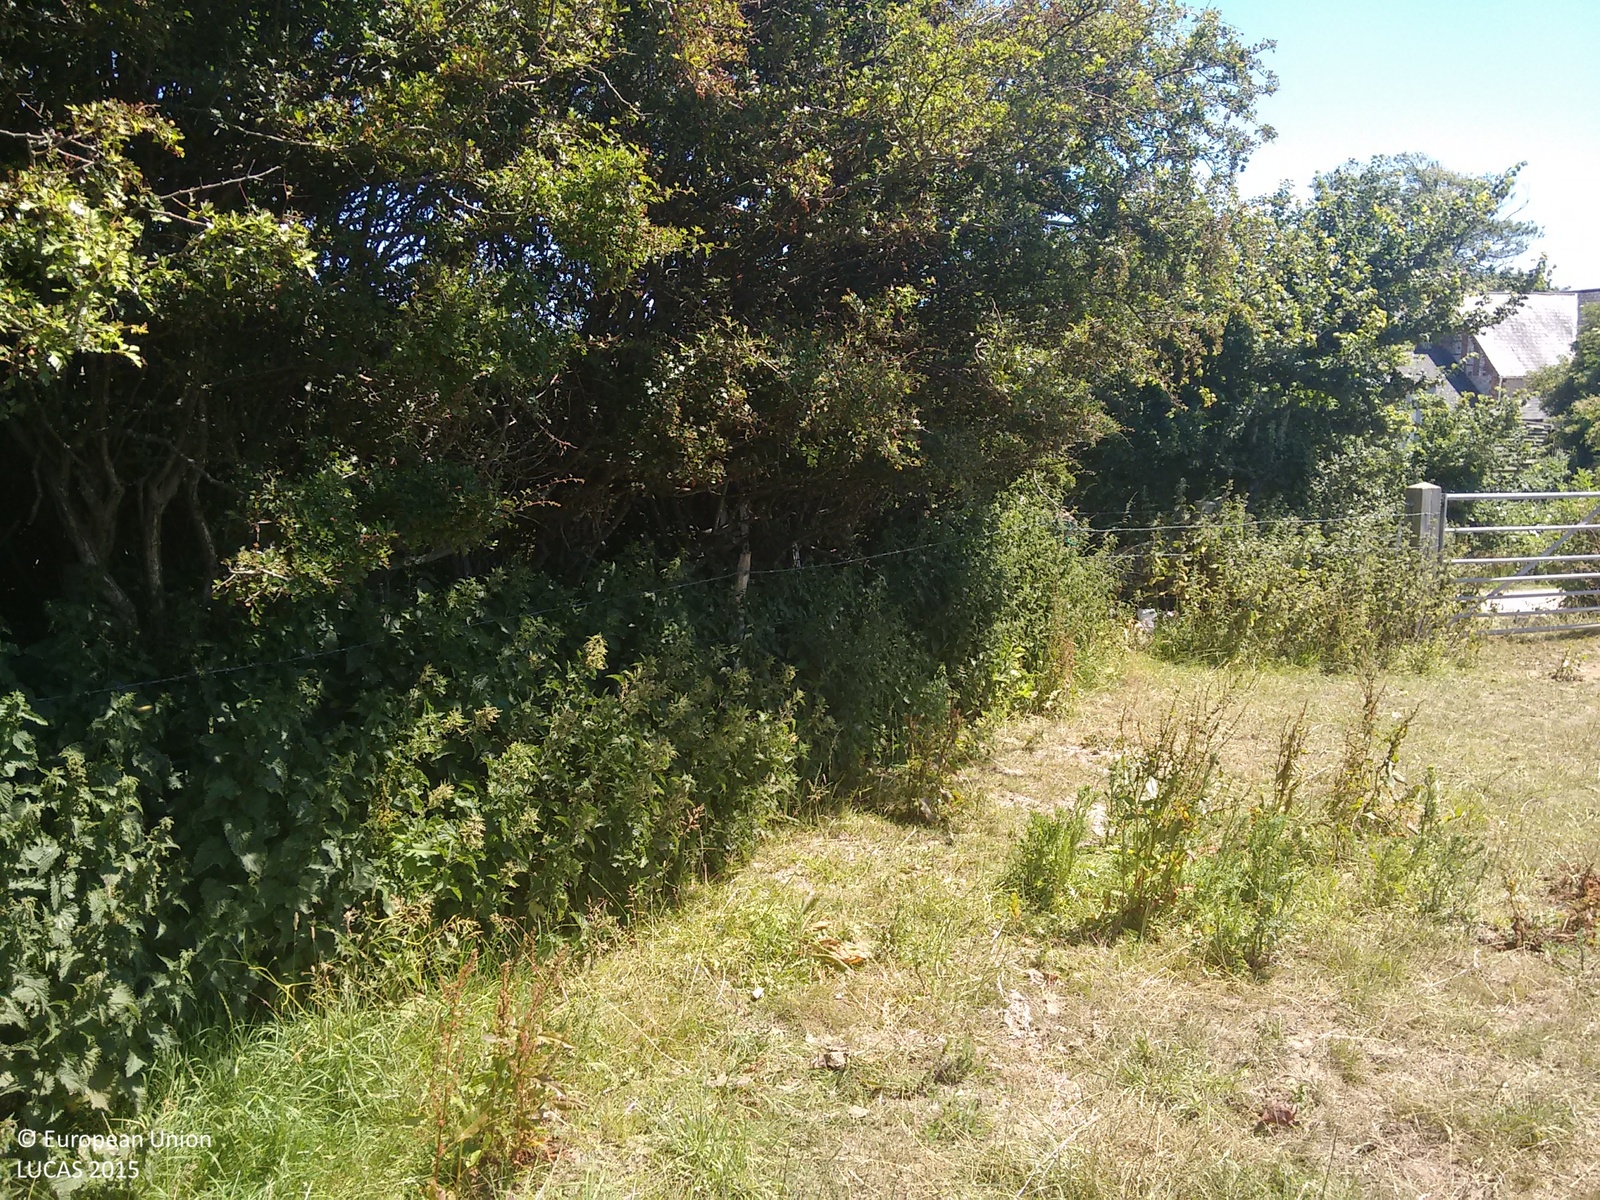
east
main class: Grassland
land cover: Grassland without tree/shrub cover
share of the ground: > 75 %
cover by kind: herbaceous plants 100 %
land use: Agriculture (excluding fallow land and kitchen gardens)
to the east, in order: Grassland without tree/shrub cover; Fences; Managed hedges; Paved roads, cycling and walking lanes; Managed hedges; Fences; Grassland without tree/shrub cover; Artificial constructions in urban areas
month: June
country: GB
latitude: 50.8352
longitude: -0.3595
